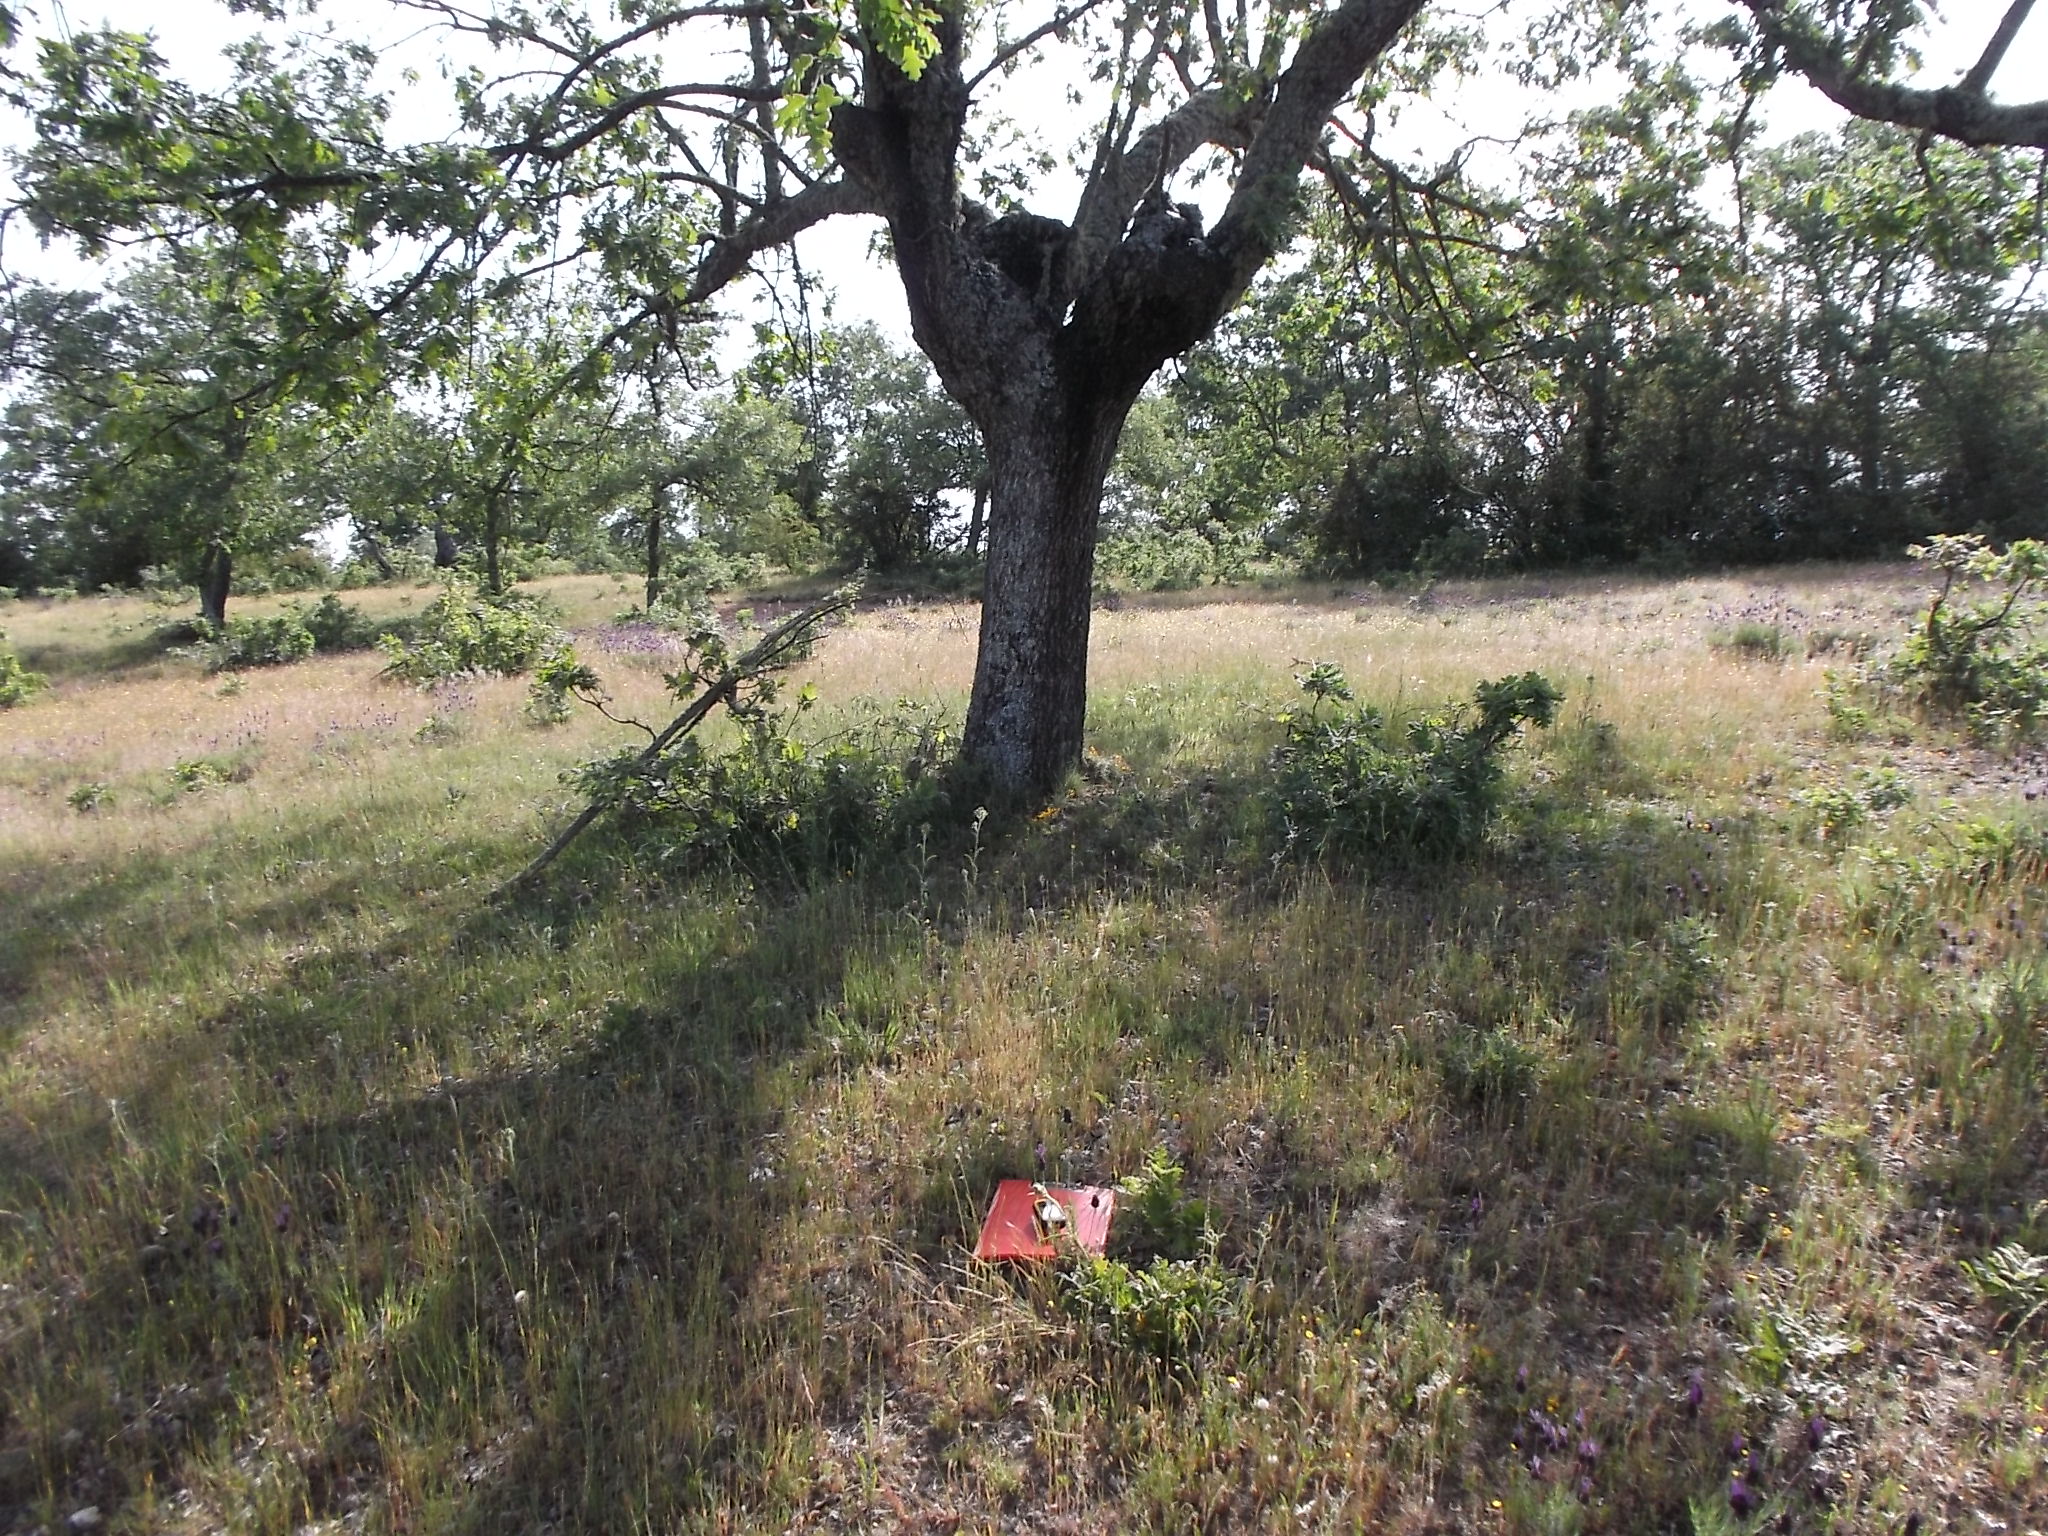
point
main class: Grassland
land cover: Grassland with sparse tree/shrub cover
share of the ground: > 75 %
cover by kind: herbaceous plants 90 %, broadleaved forest trees 5 %, shrubs 5 %
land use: Agriculture (excluding fallow land and kitchen gardens)
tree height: > 5 m
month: May
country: ES
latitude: 40.9894
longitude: -6.3163
